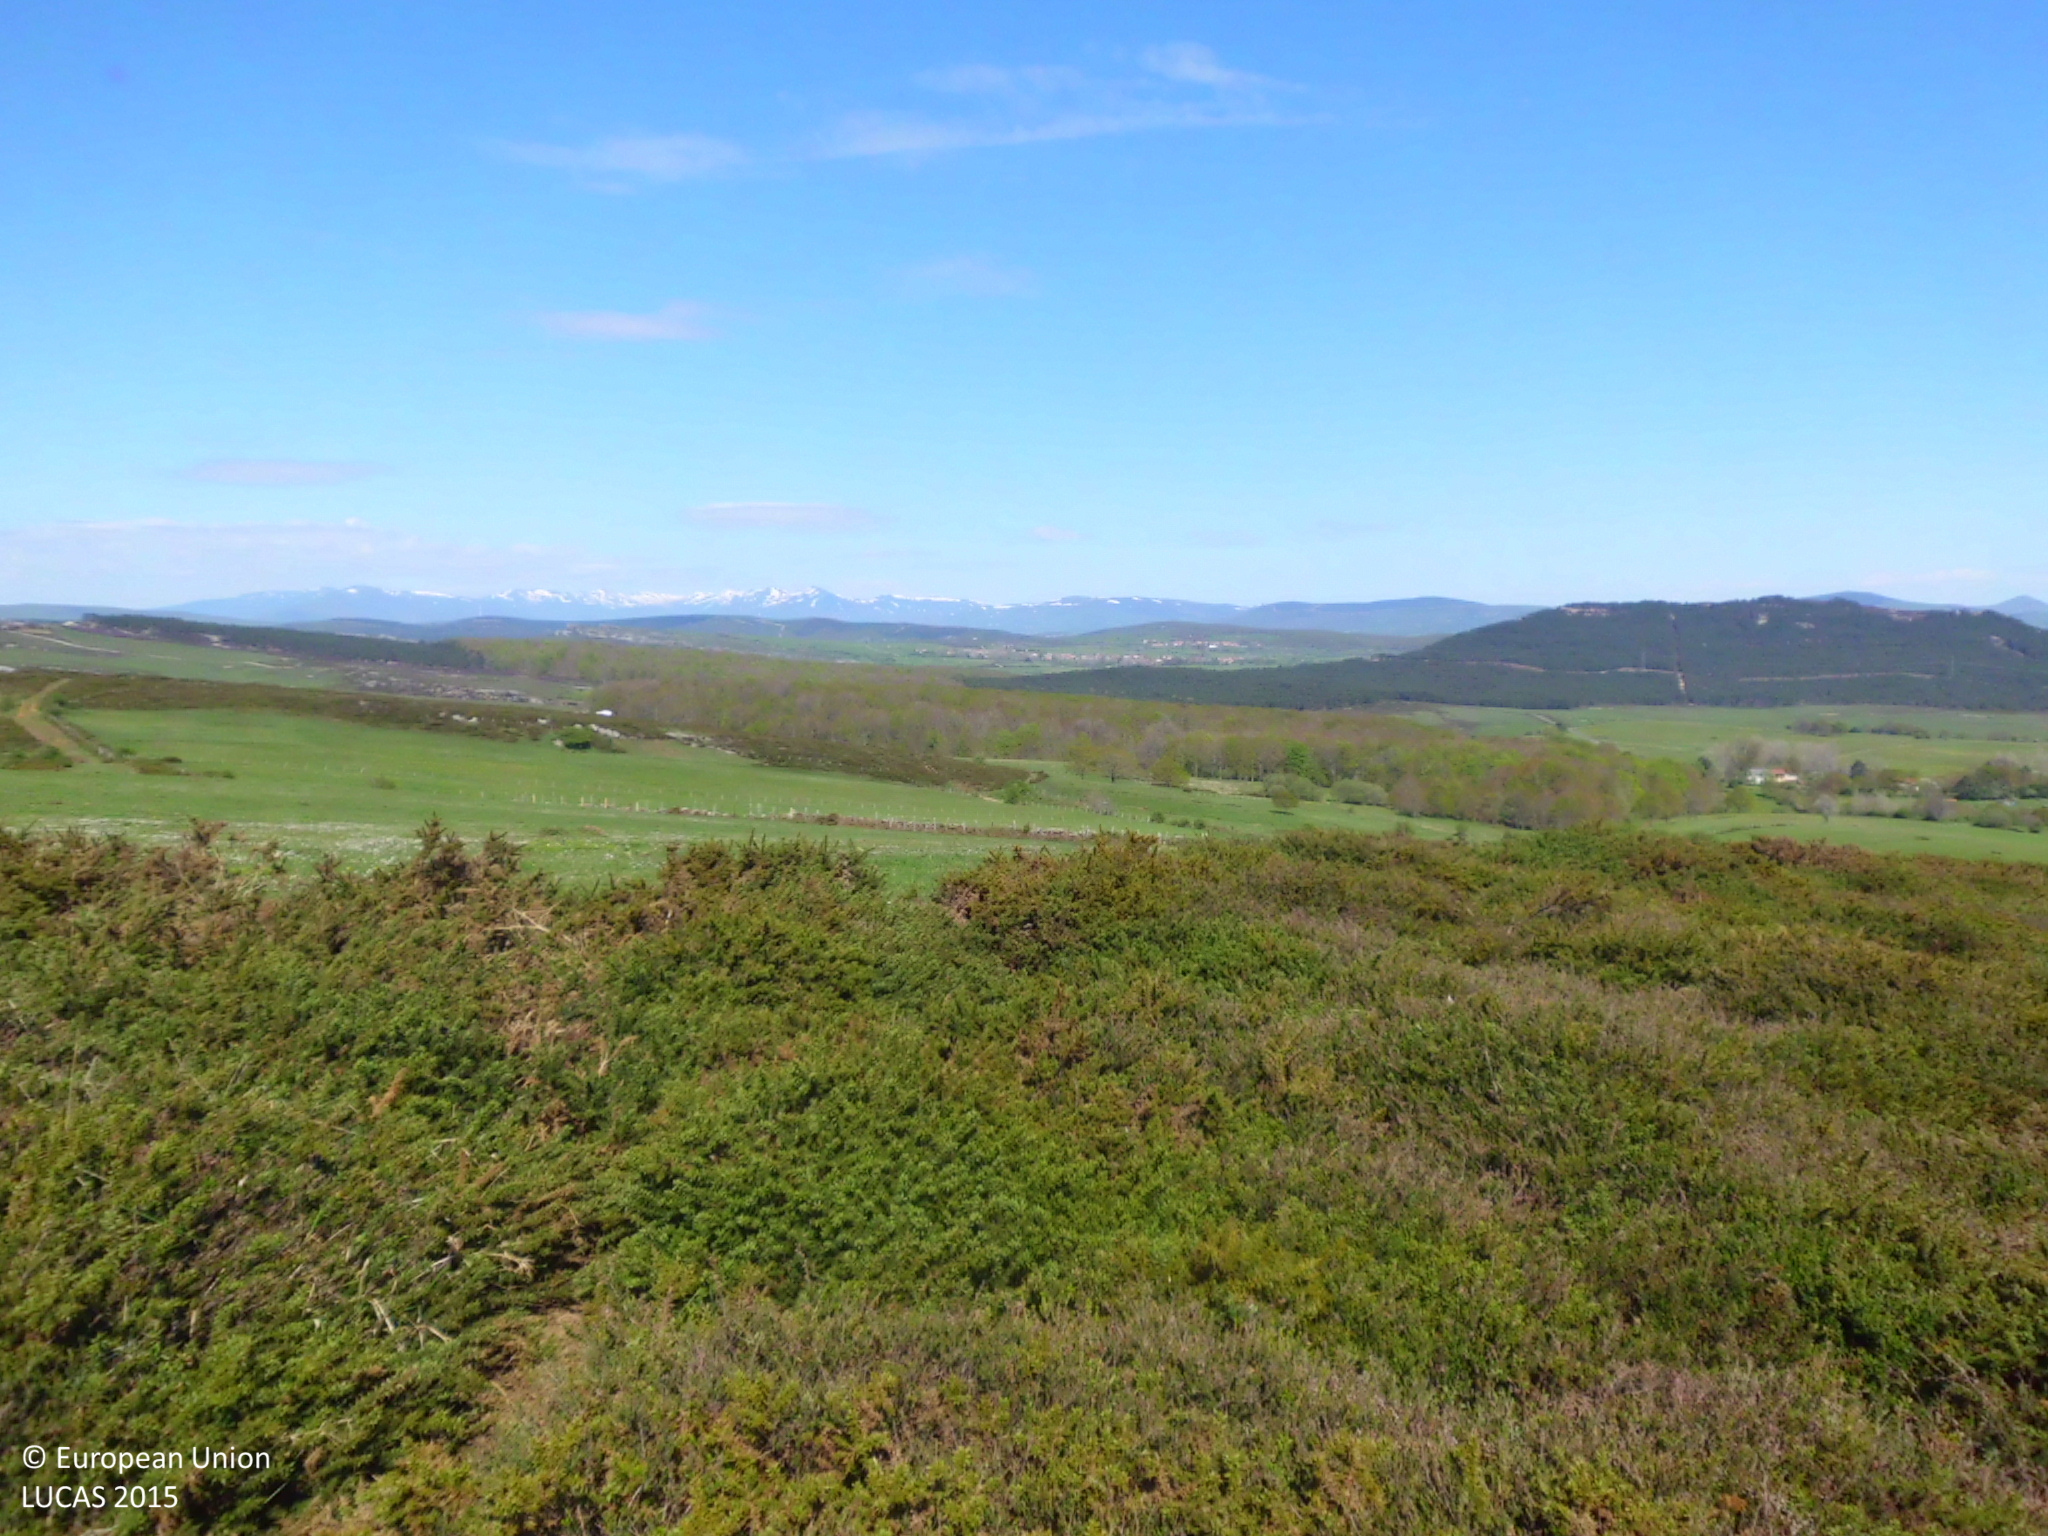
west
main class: Shrubland
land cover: Shrubland without tree cover
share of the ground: > 75 %
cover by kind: shrubs 80 %, herbaceous plants 20 %
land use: Semi-natural and natural areas not in use
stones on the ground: 25 - 50 %
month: May
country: ES
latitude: 42.9338
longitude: -3.9044
